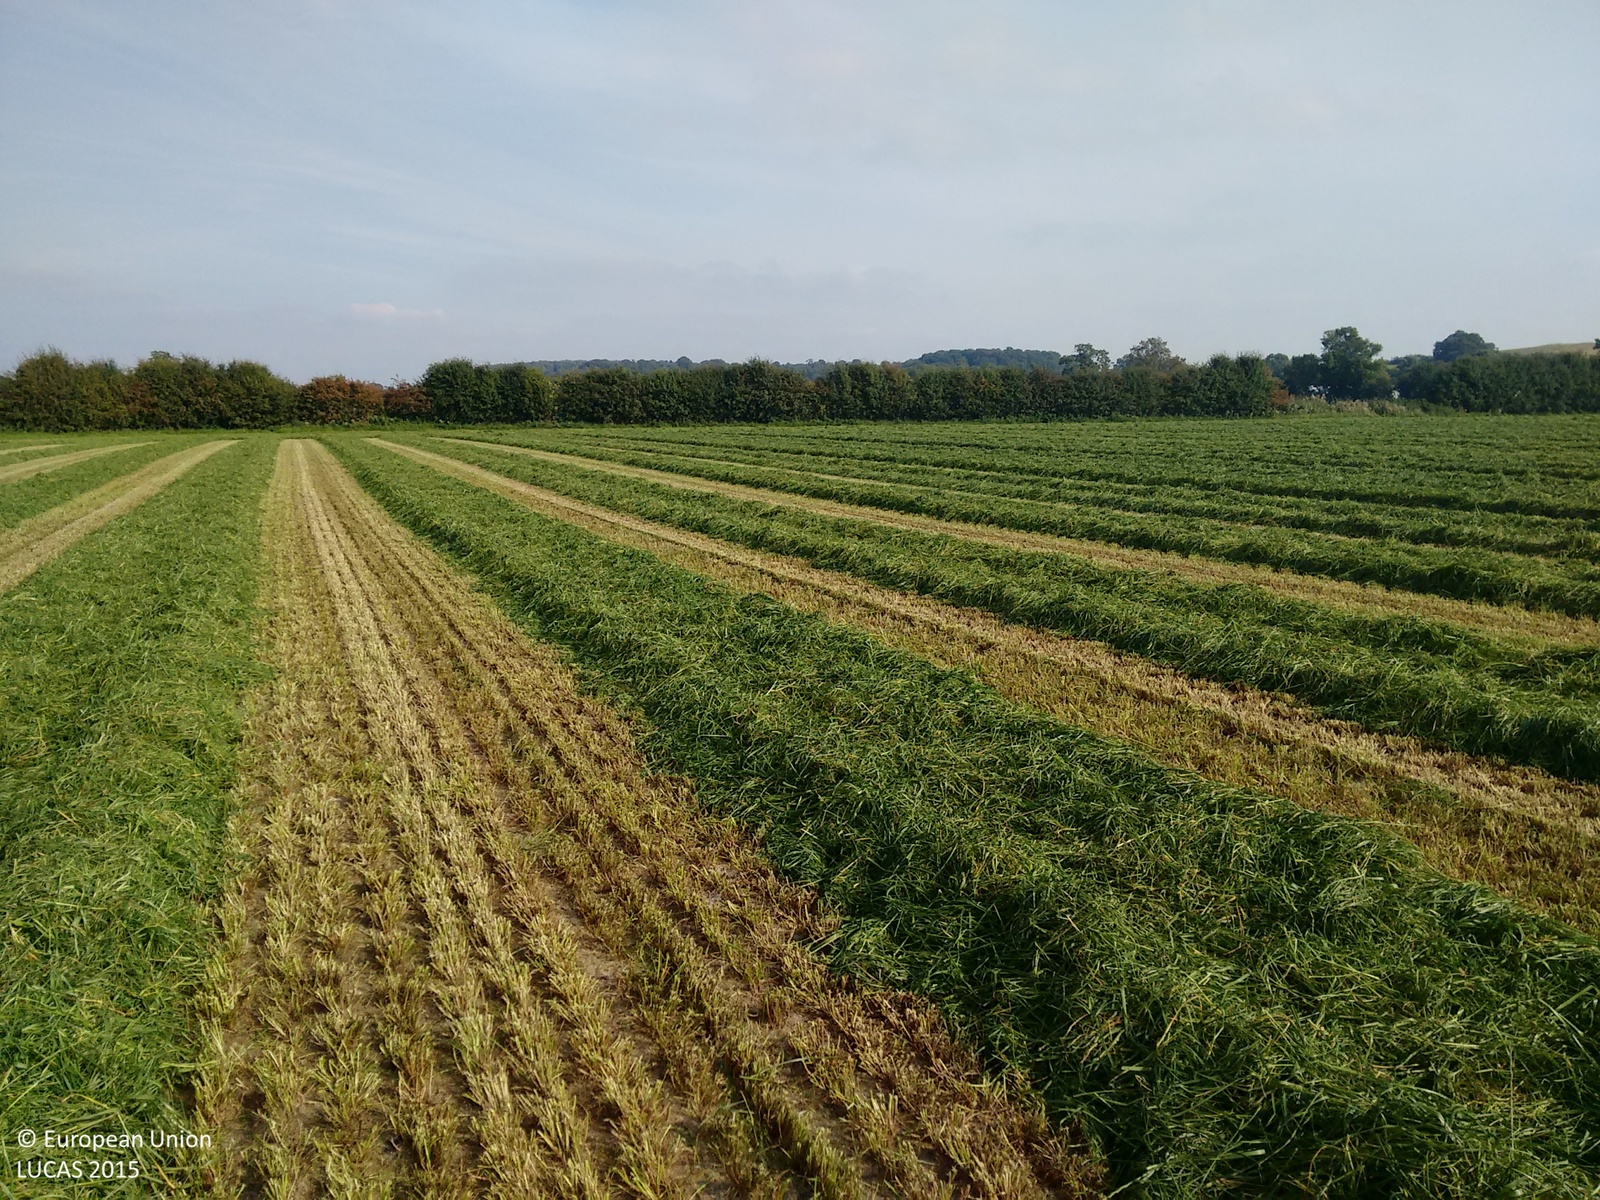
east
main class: Grassland
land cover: Grassland without tree/shrub cover
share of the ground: > 75 %
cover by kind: herbaceous plants 100 %
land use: Agriculture (excluding fallow land and kitchen gardens)
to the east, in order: Grassland without tree/shrub cover; Managed hedges; Fences; Grass margins; Other bare soil
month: September
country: GB
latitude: 52.7698
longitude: -2.3208
